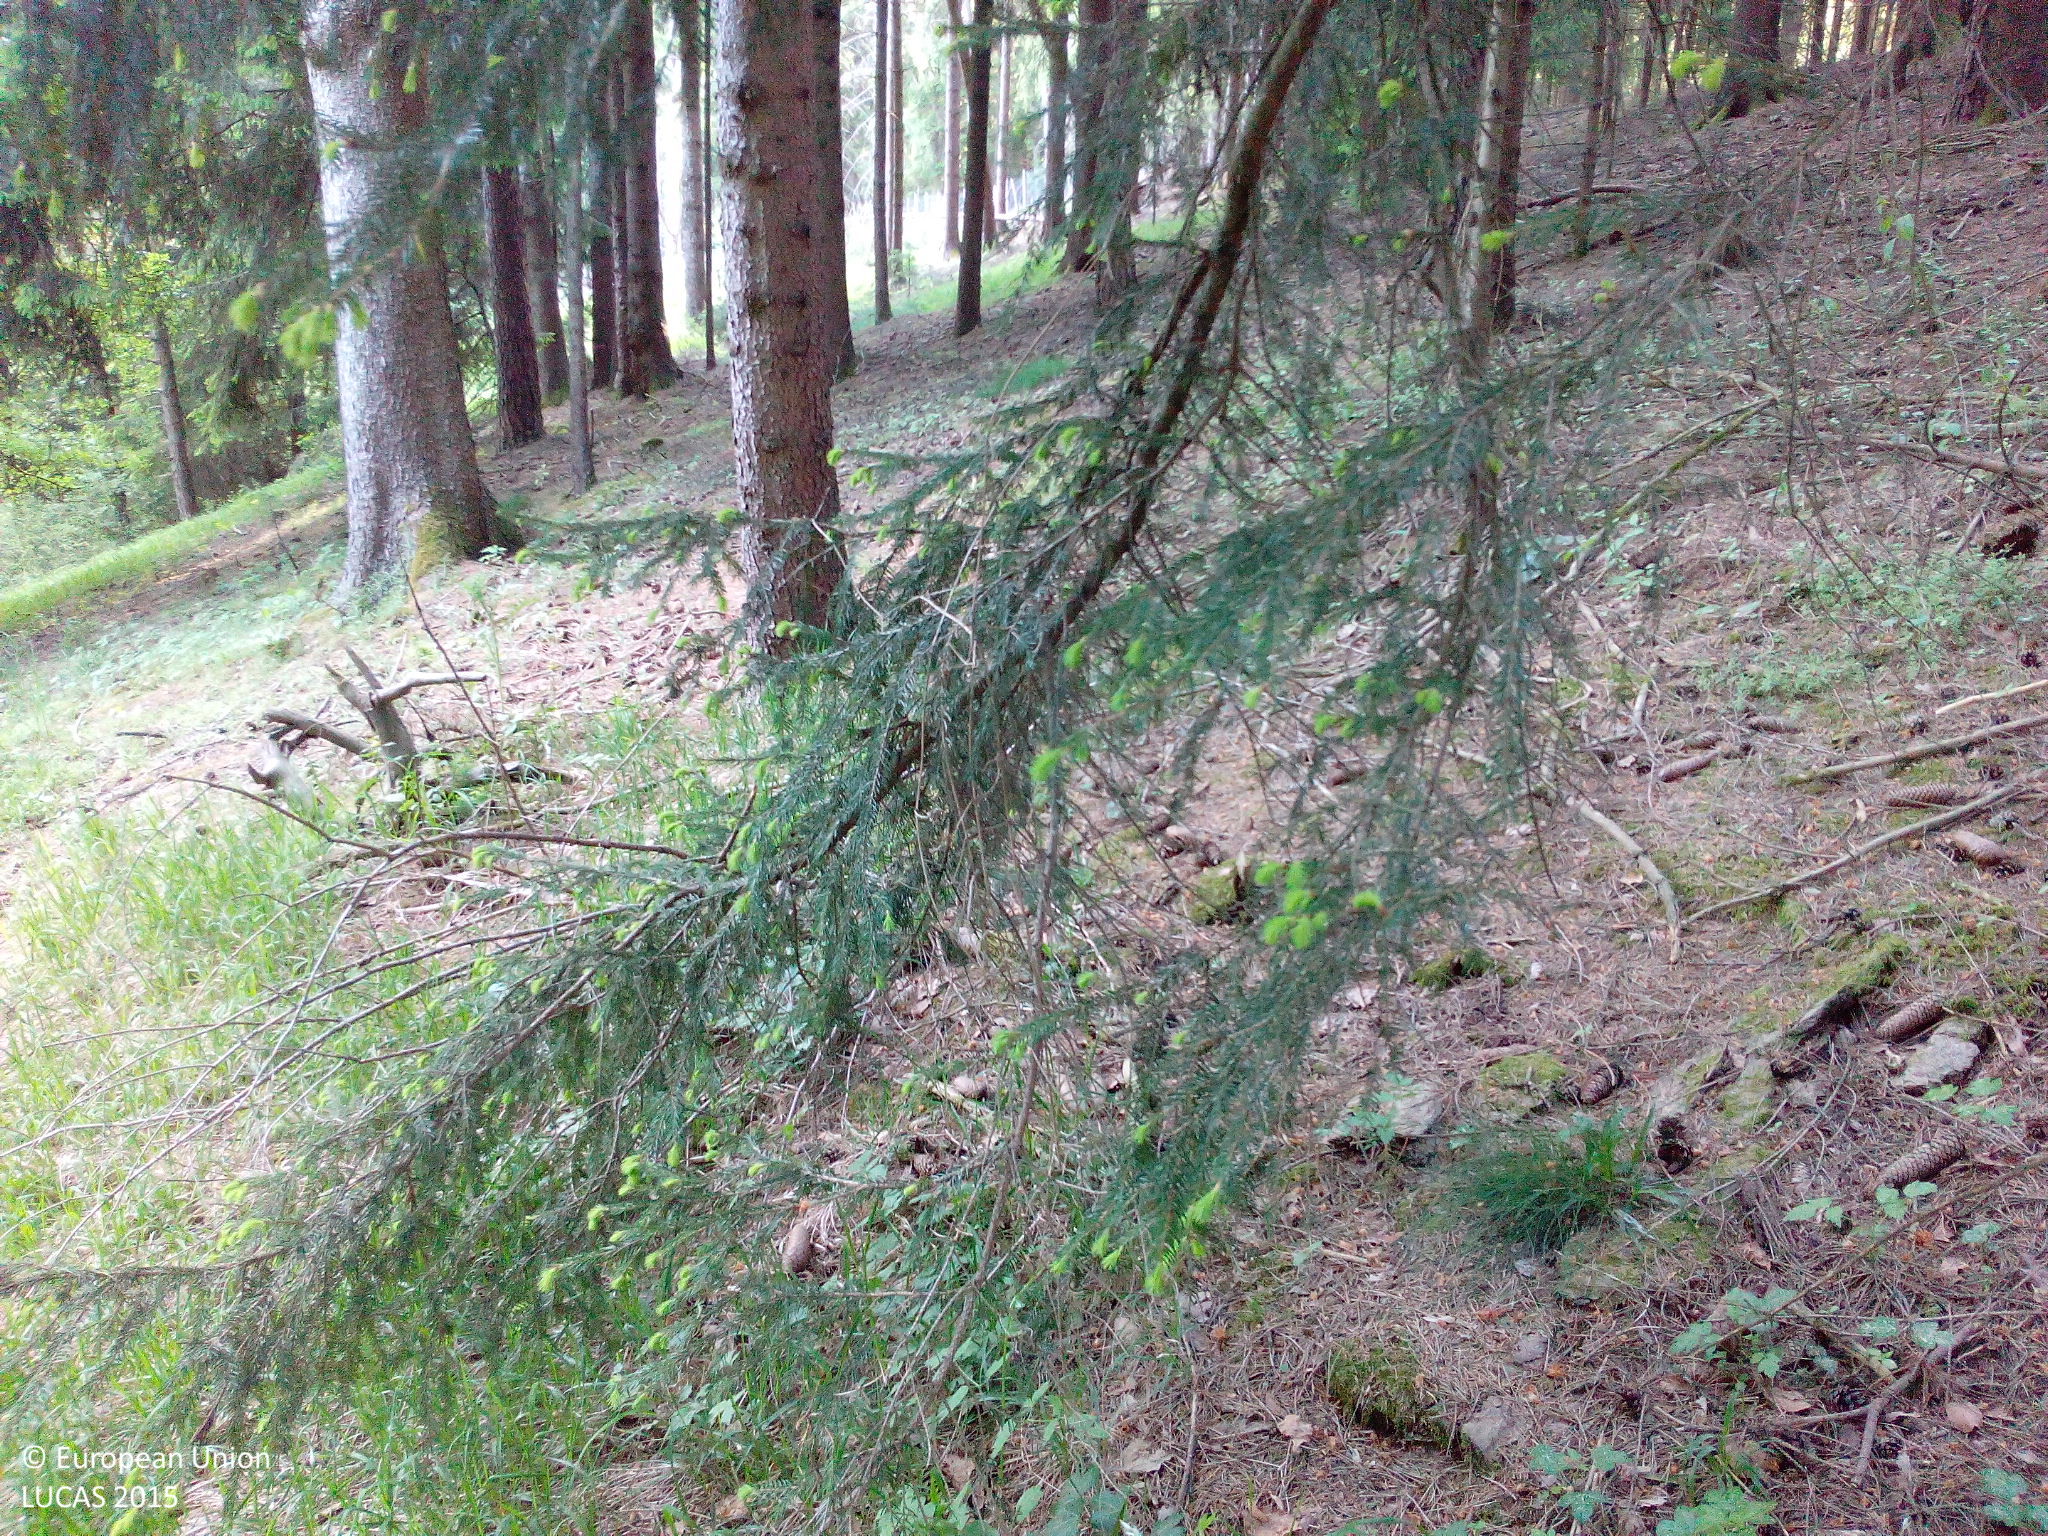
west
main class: Woodland
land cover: Other coniferous woodland
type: hemiboreal forest and nemoral coniferous forest and mixed broadleaved-coniferous forest
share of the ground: > 75 %
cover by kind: coniferous forest trees 85 %, unconsolidated bare surface 10 %, herbaceous plants 5 %
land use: Forestry
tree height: > 5 m
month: May
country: DE
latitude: 49.1851
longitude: 11.4949
